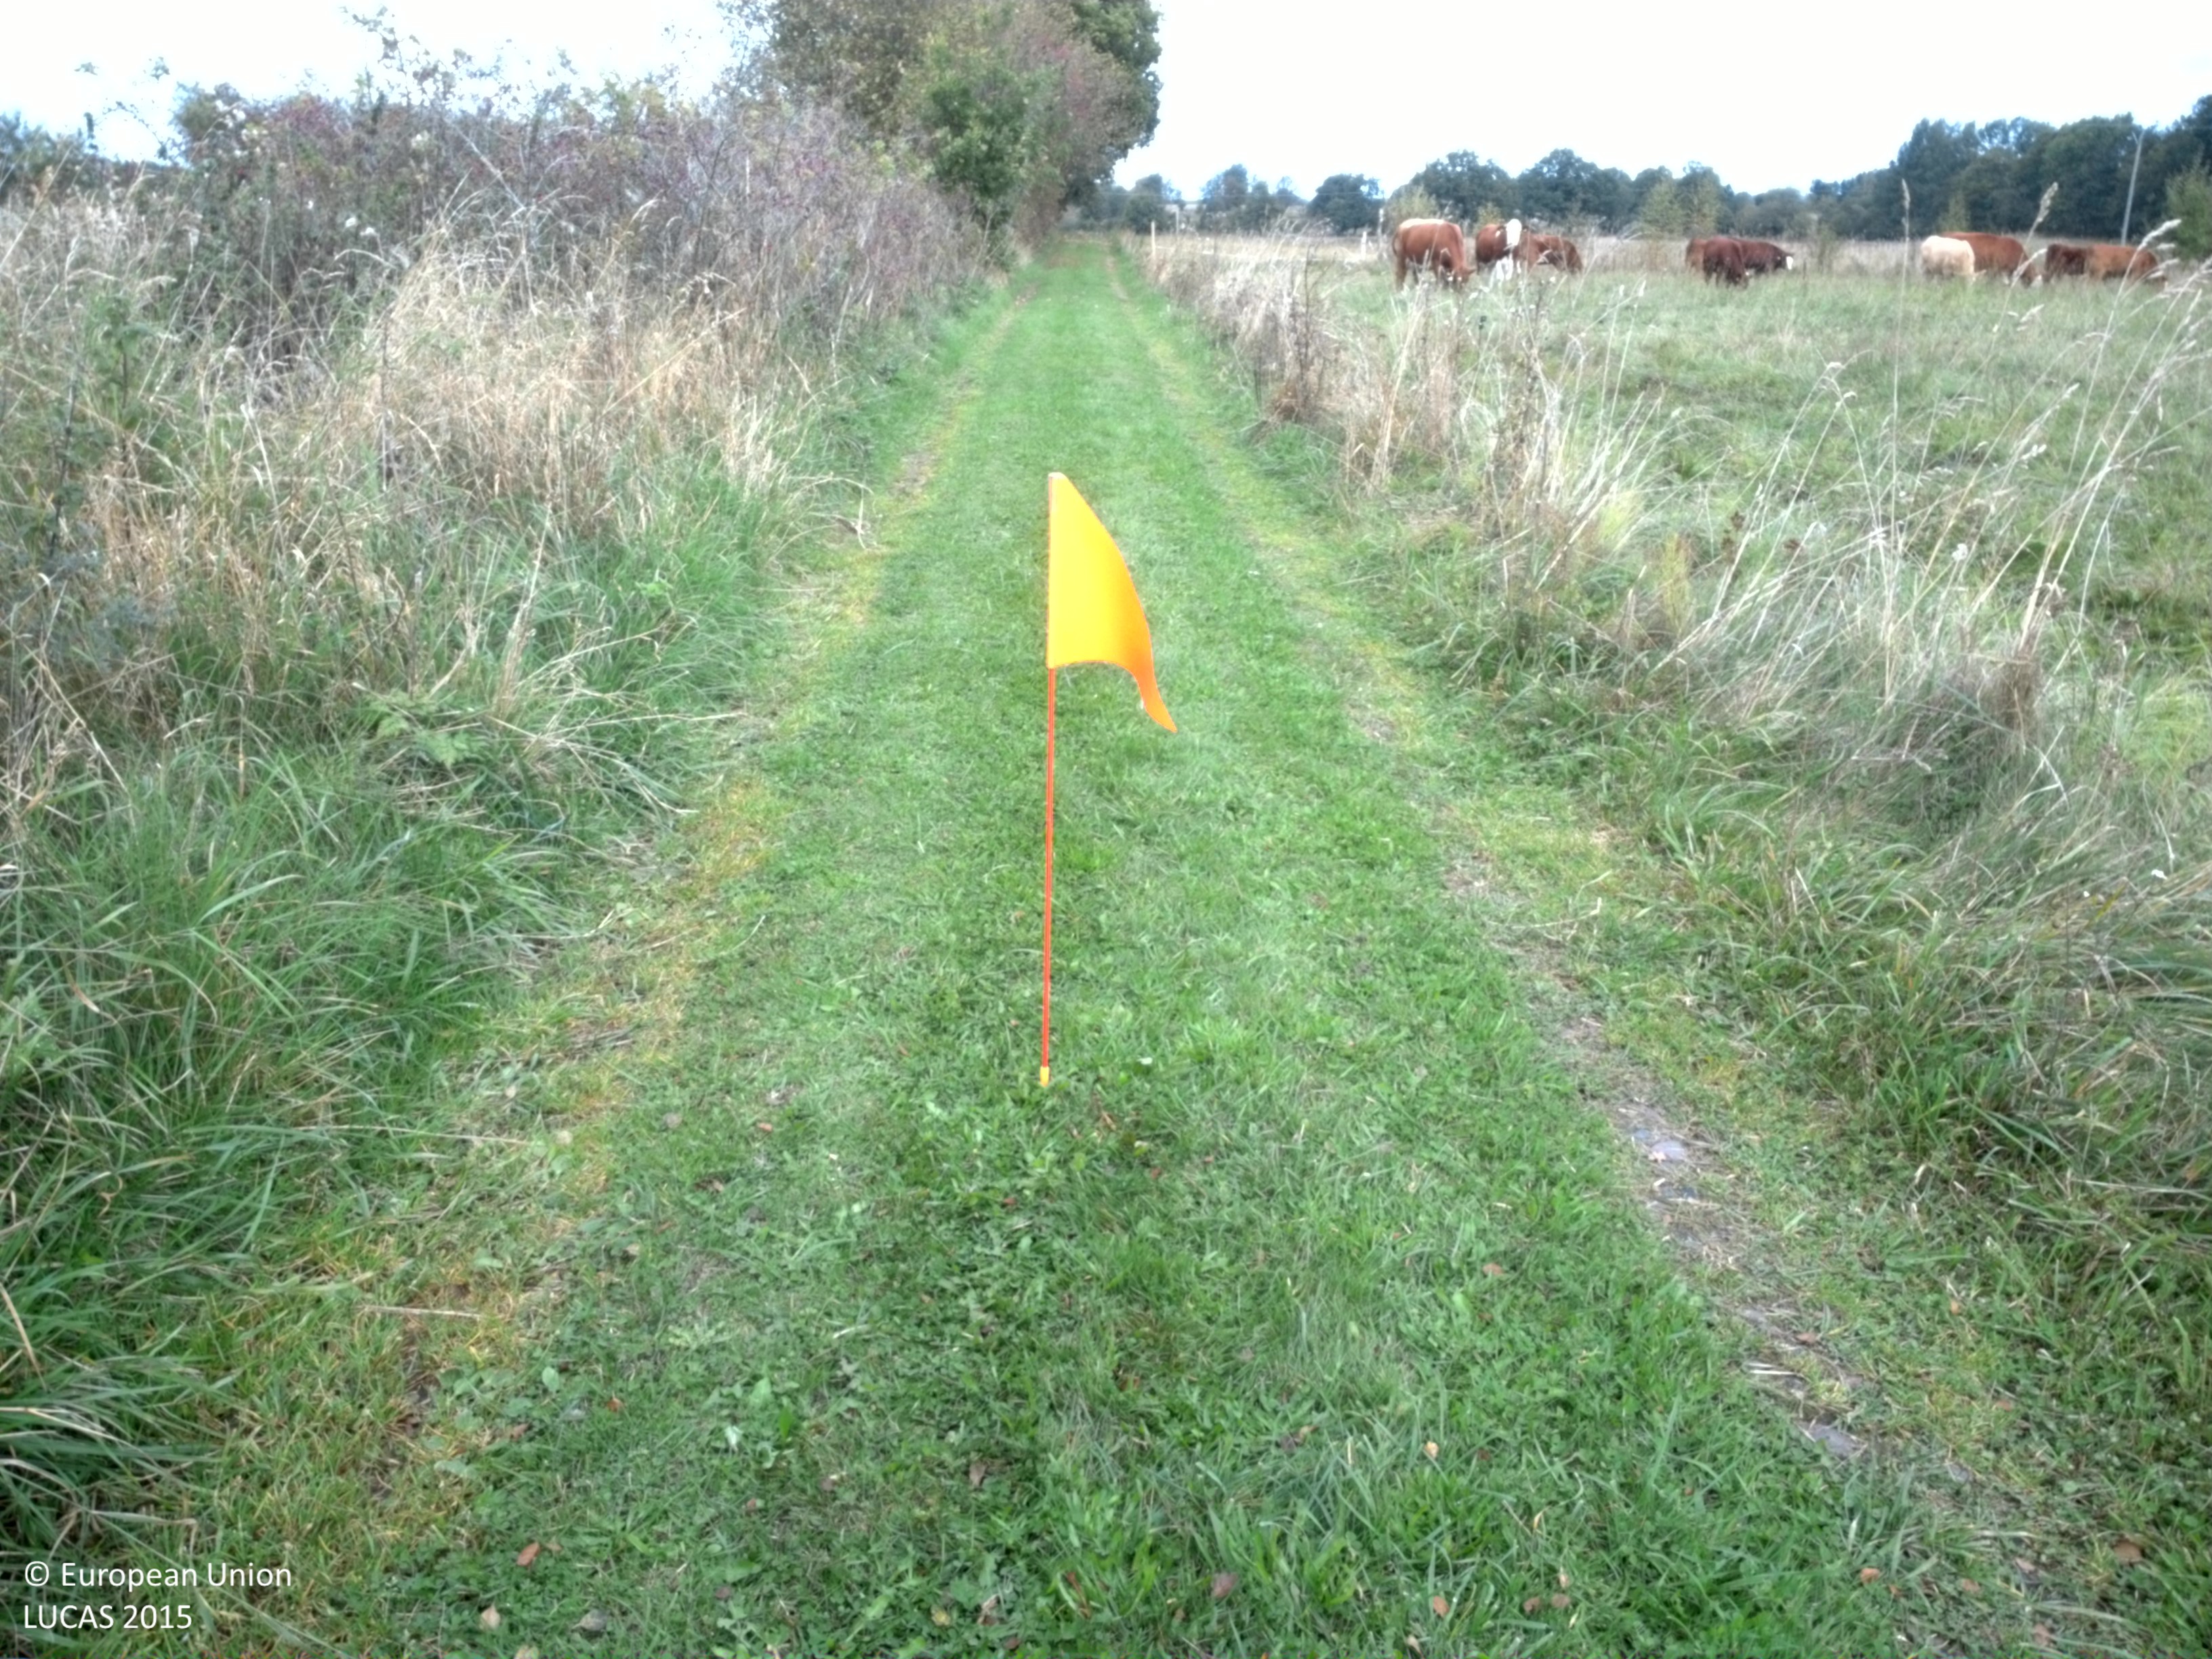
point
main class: Grassland
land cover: Grassland without tree/shrub cover
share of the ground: > 75 %
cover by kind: herbaceous plants 100 %
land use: Agriculture (excluding fallow land and kitchen gardens)
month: October
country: SE
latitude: 55.7383
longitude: 13.7091
